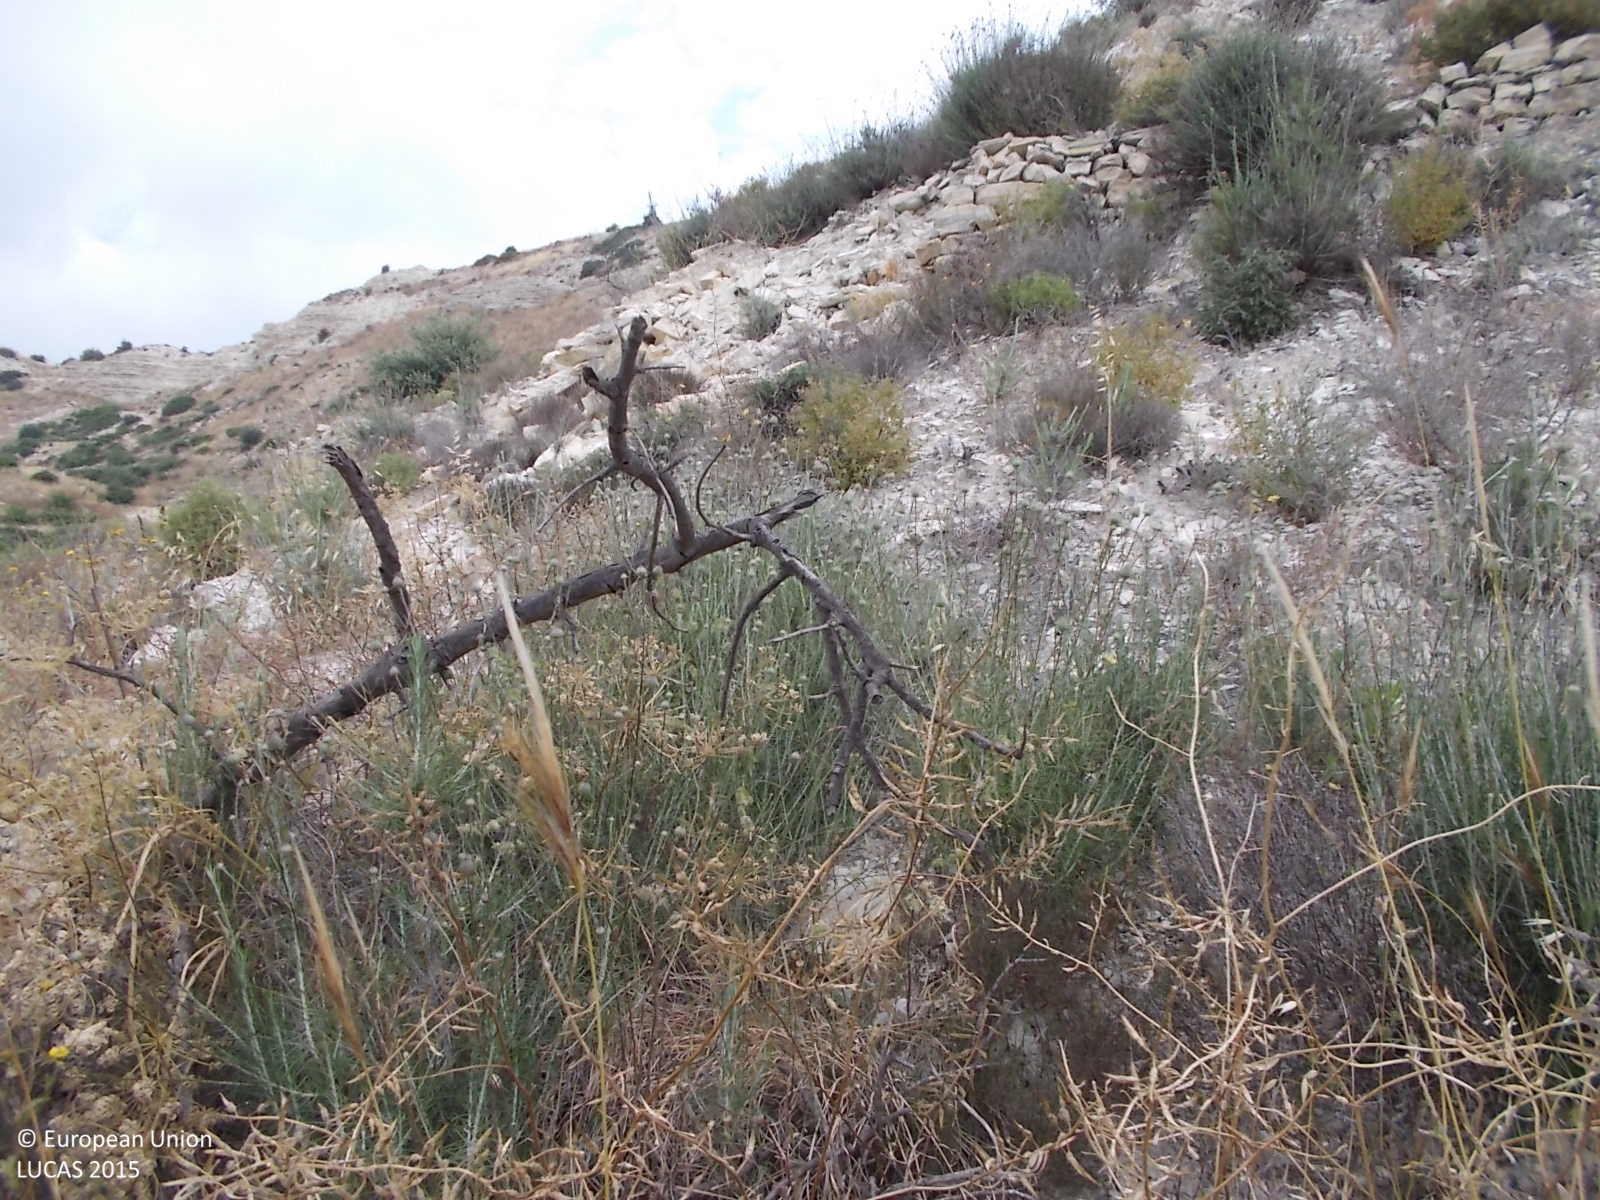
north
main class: Shrubland
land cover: Shrubland with sparse tree cover
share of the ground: > 75 %
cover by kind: shrubs 80 %, unconsolidated bare surface 15 %, broadleaved forest trees 5 %
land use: Semi-natural and natural areas not in use
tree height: < 5 m
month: May
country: CY
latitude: 34.7760
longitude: 33.2884
